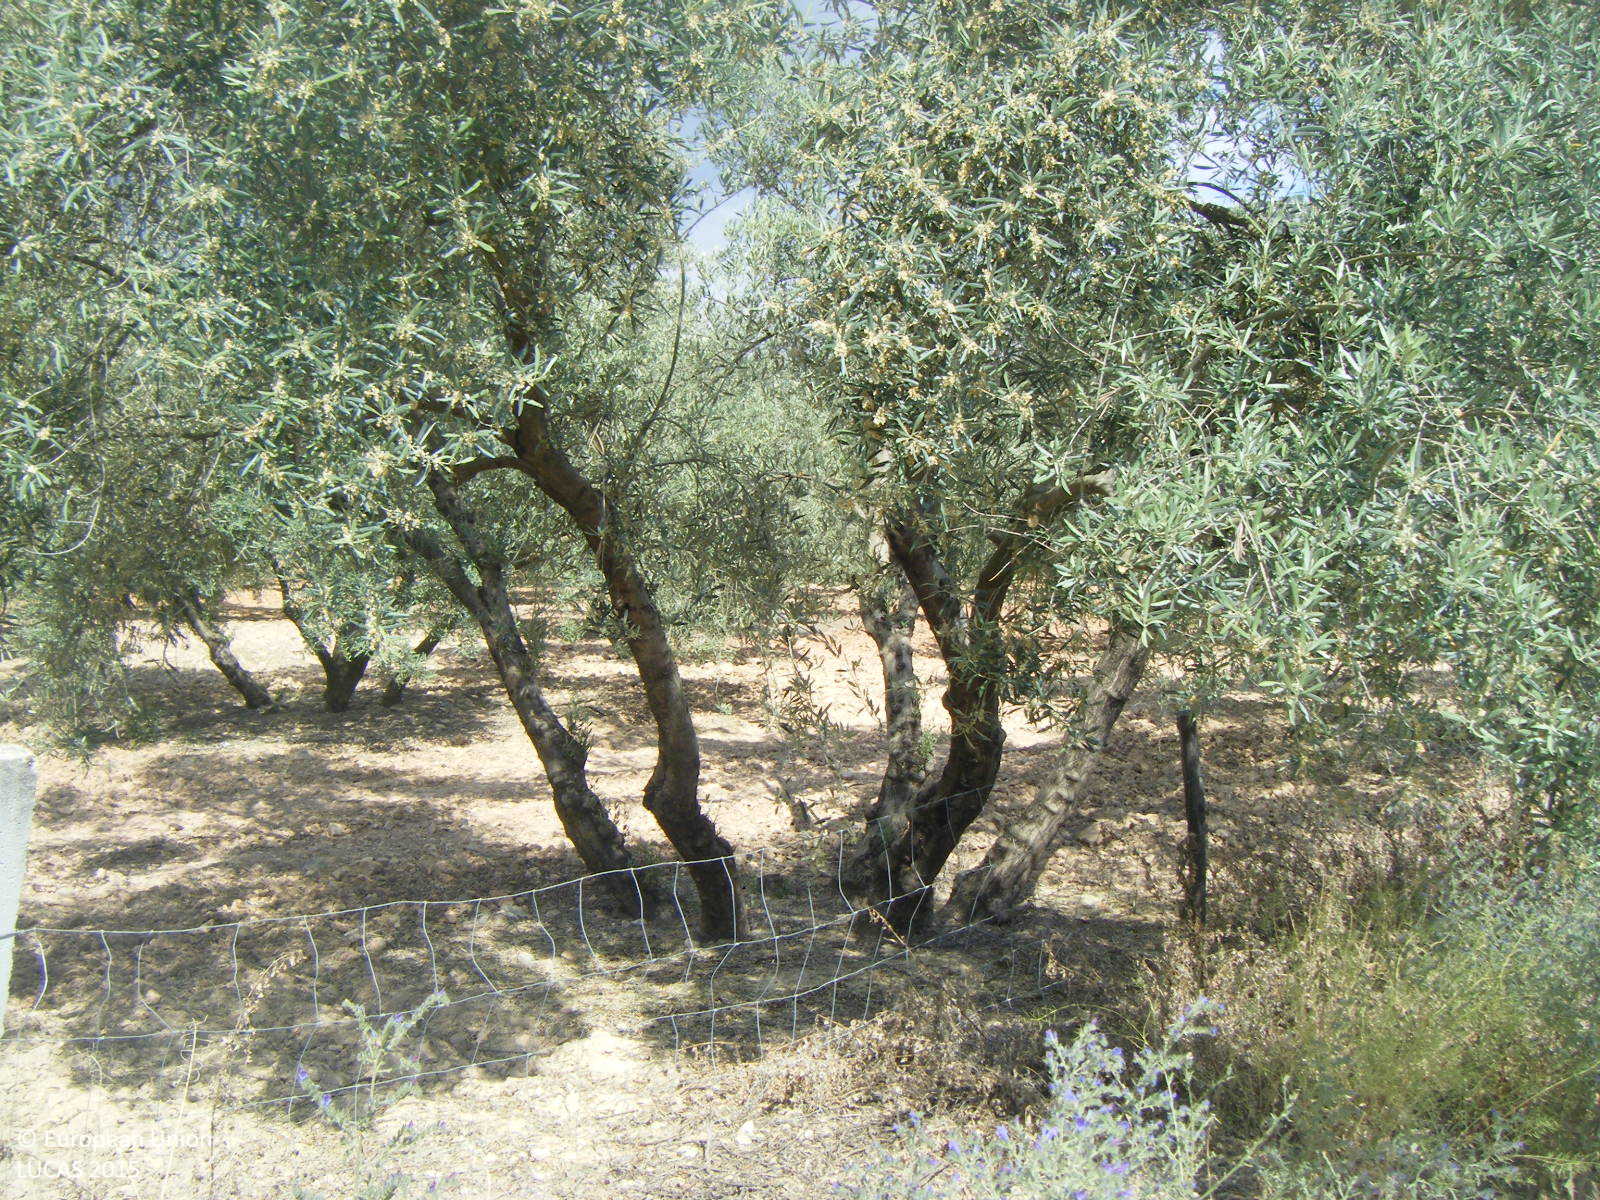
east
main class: Cropland
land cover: Olive groves
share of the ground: 10 - 25 %
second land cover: Other bare soil
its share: > 75 %
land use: Agriculture (excluding fallow land and kitchen gardens)
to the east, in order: Olive groves; Other bare soil; Fences; Shruby margins; Paved roads, cycling and walking lanes; Other structural elements; Olive groves
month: May
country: ES
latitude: 37.1246
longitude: -4.3923
